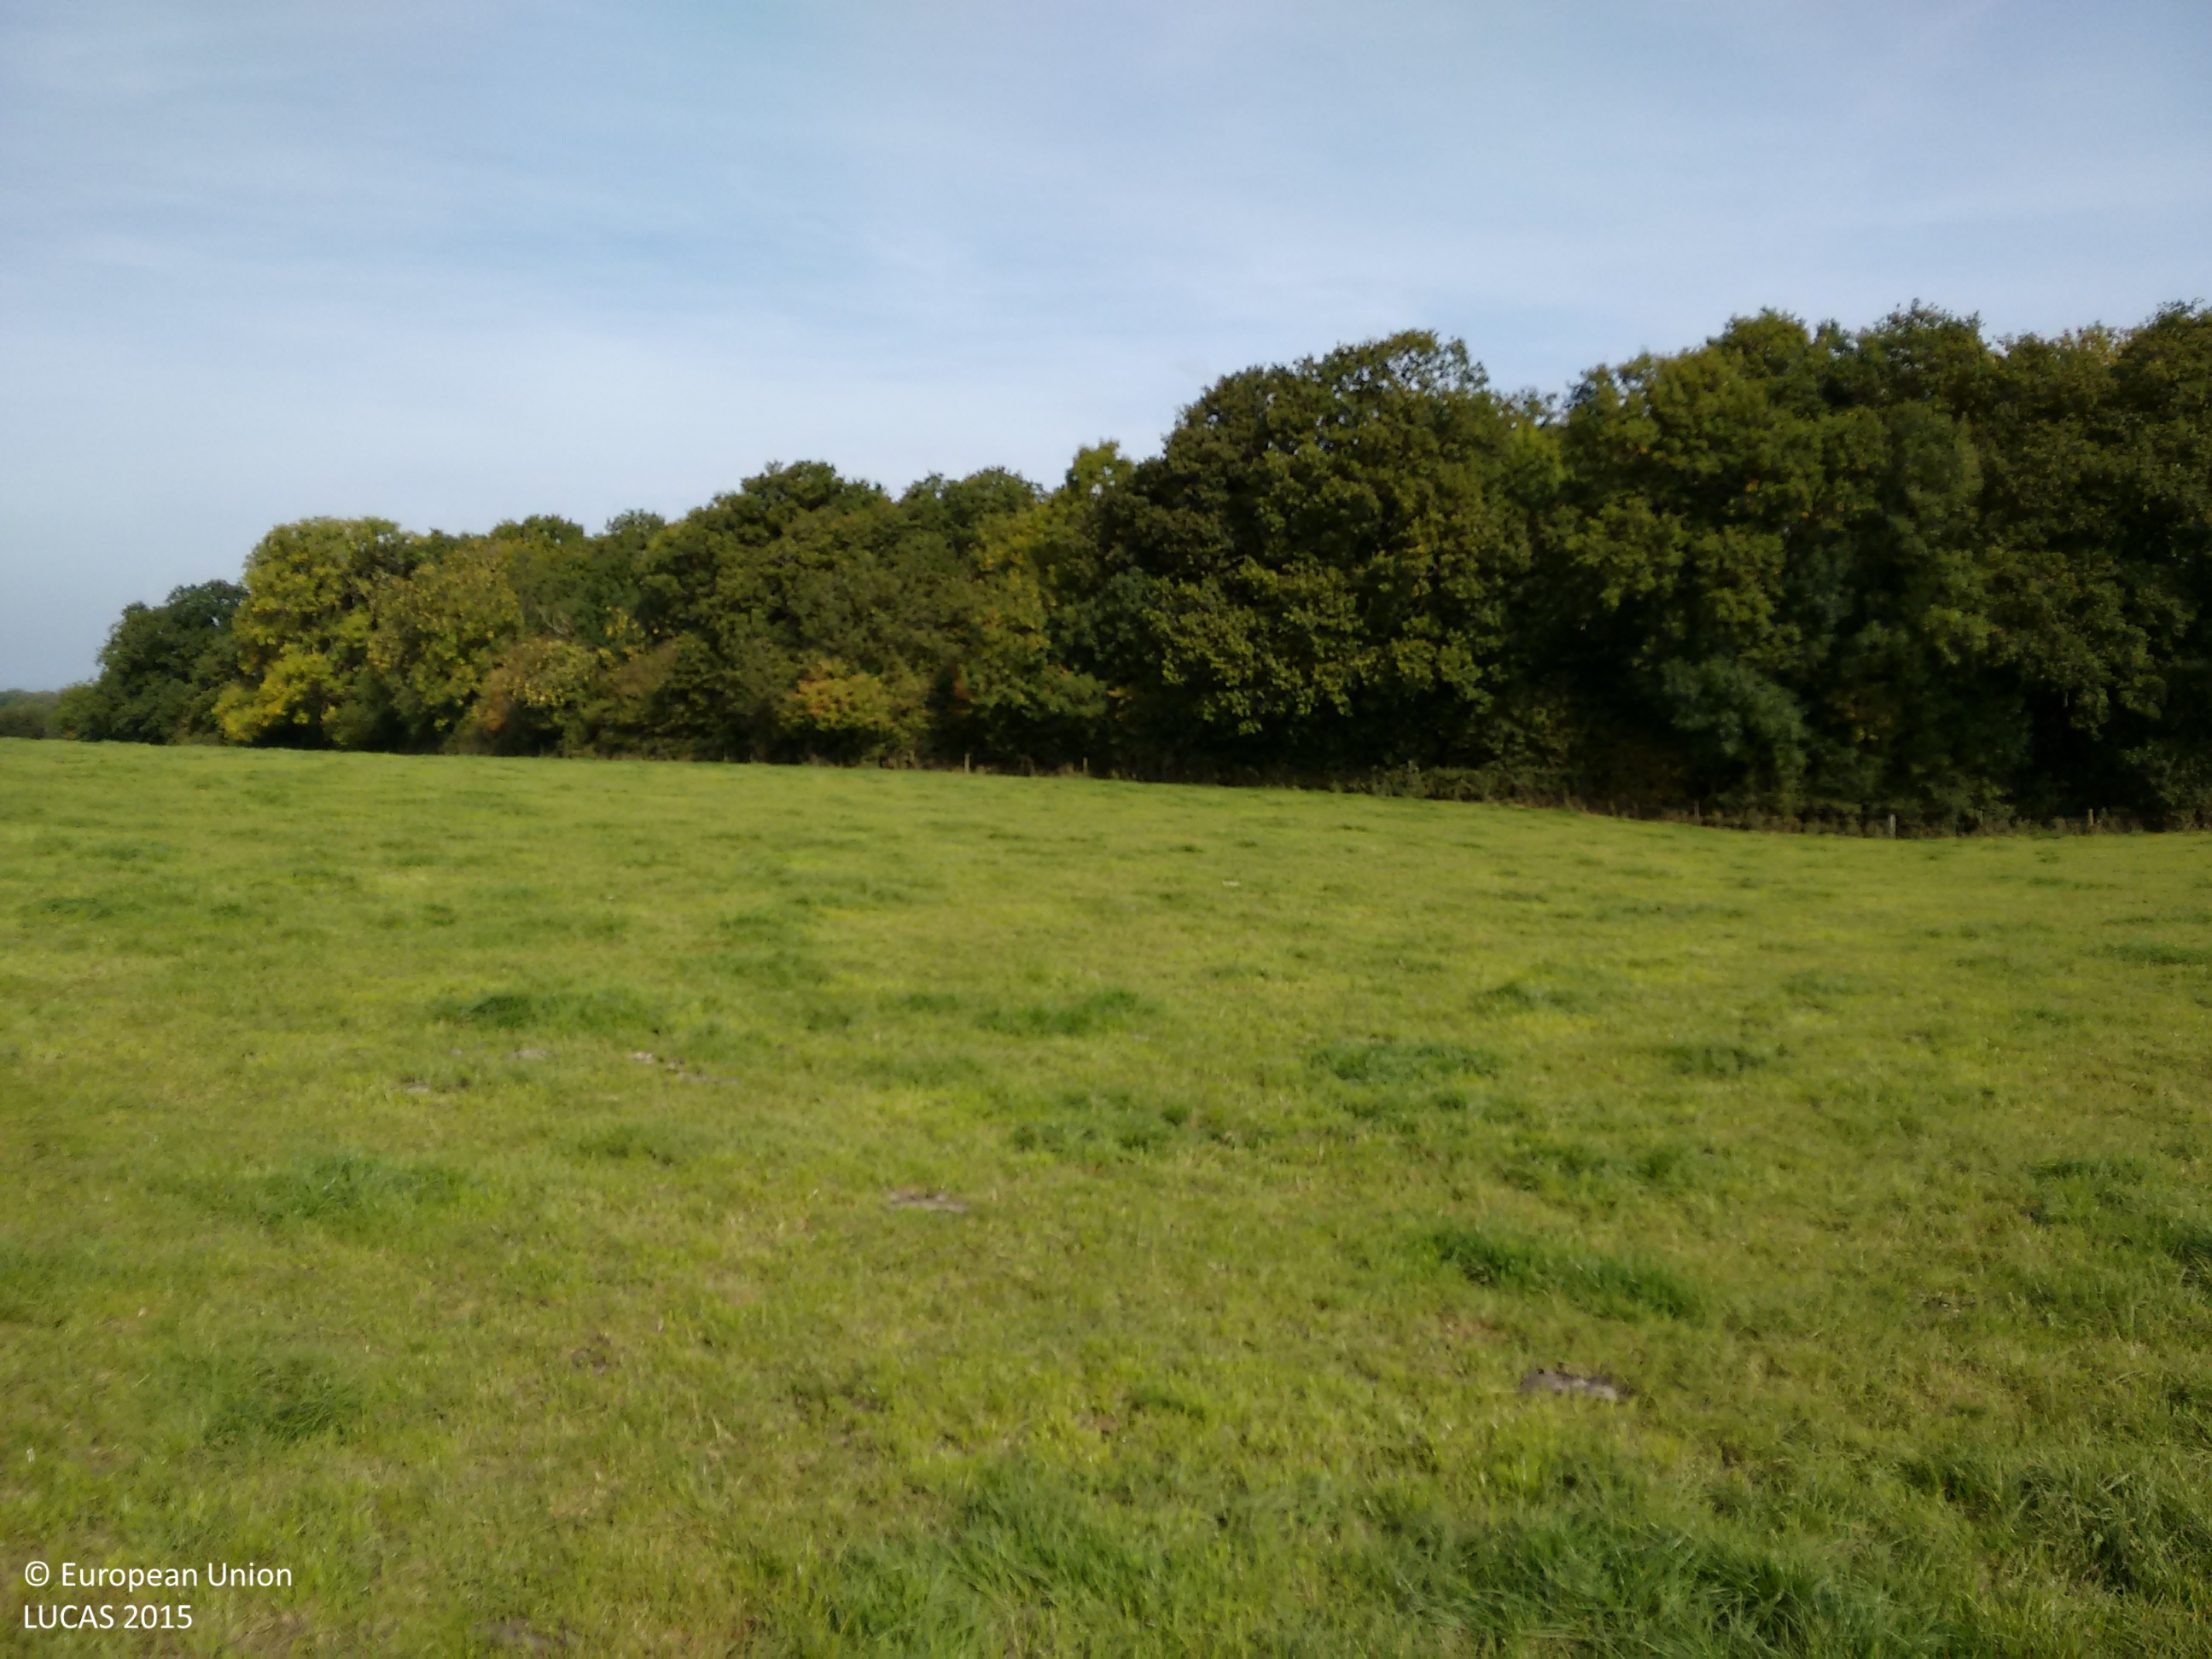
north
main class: Grassland
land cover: Grassland without tree/shrub cover
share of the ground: > 75 %
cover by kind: herbaceous plants 100 %
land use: Agriculture (excluding fallow land and kitchen gardens)
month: September
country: GB
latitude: 51.6313
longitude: -2.4174
